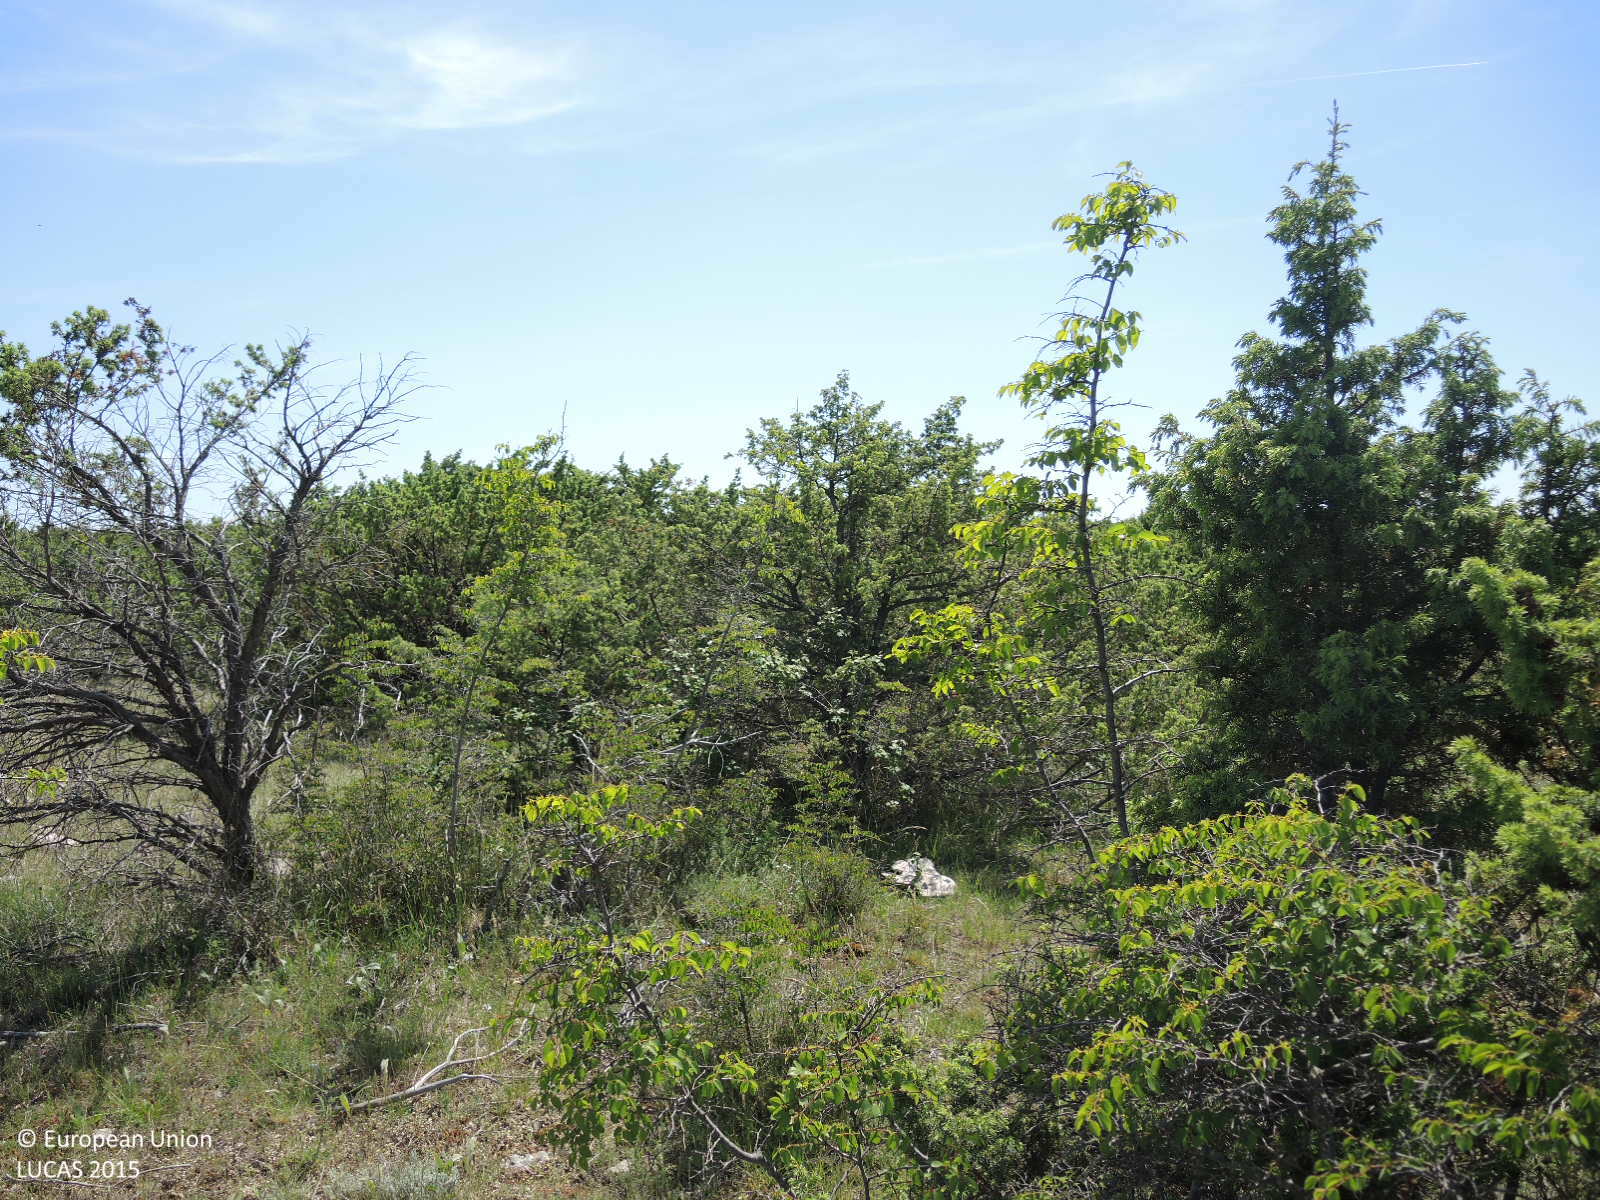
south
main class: Shrubland
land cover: Shrubland with sparse tree cover
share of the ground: 25 - 50 %
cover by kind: shrubs 45 %, herbaceous plants 45 %, coniferous forest trees 5 %, consolidated bare surface 5 %
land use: Semi-natural and natural areas not in use
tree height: < 5 m
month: May
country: HR
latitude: 43.9276
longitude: 15.9332
